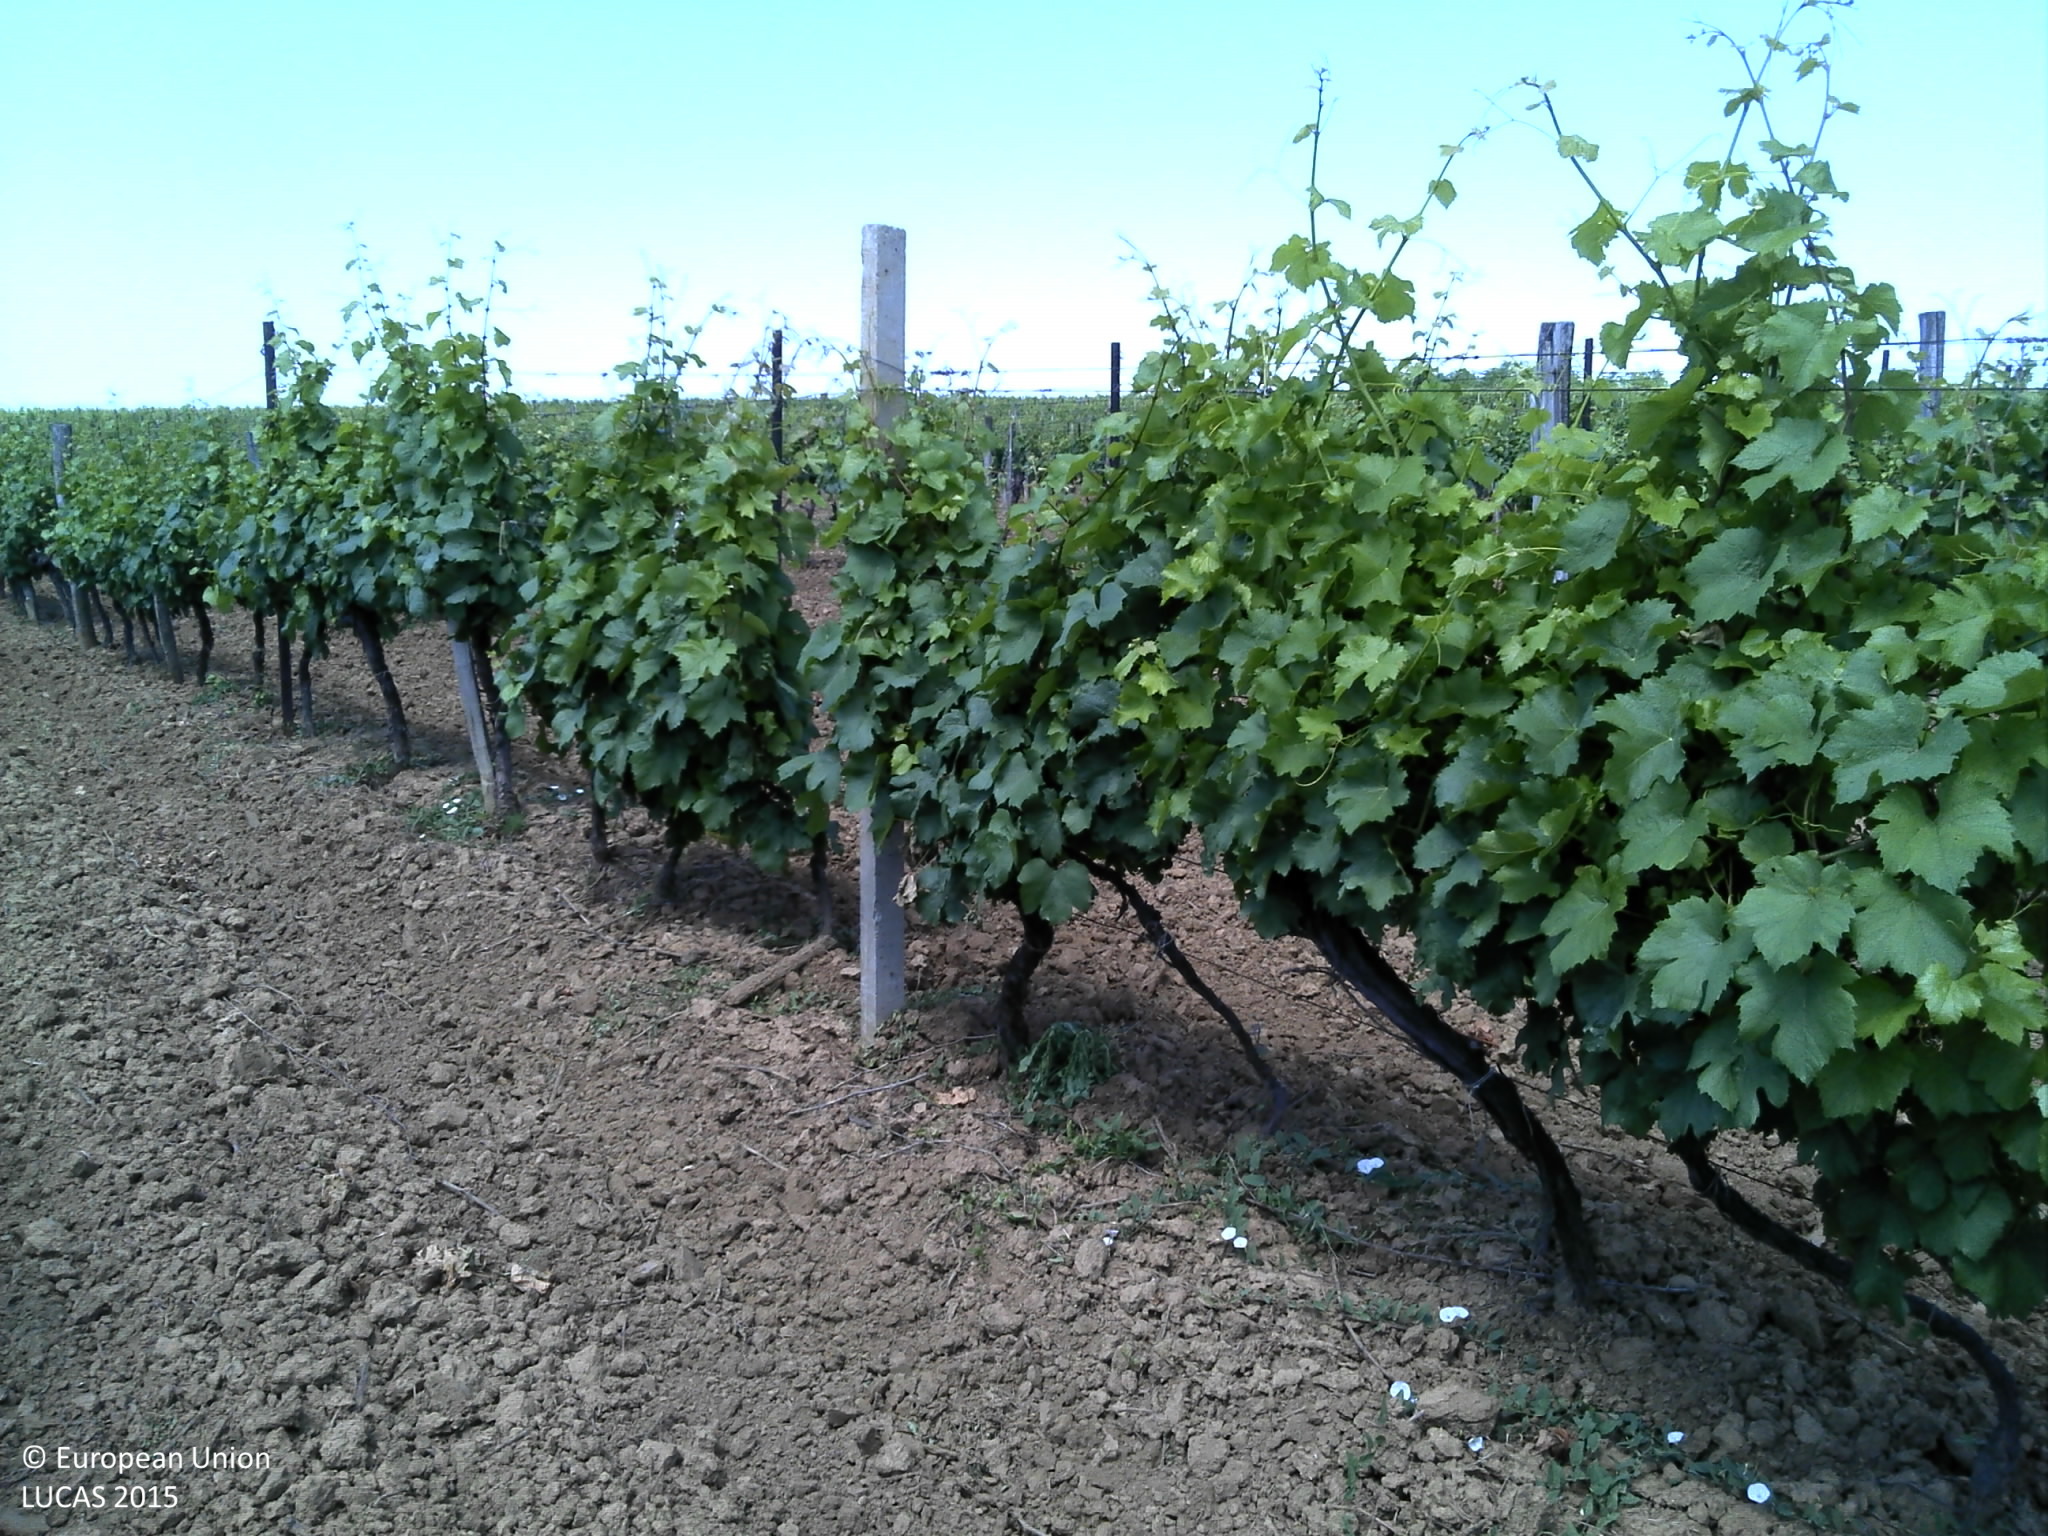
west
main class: Cropland
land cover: Vineyards
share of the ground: 25 - 50 %
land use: Agriculture (excluding fallow land and kitchen gardens)
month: June
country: HR
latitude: 45.7796
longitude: 18.6902
